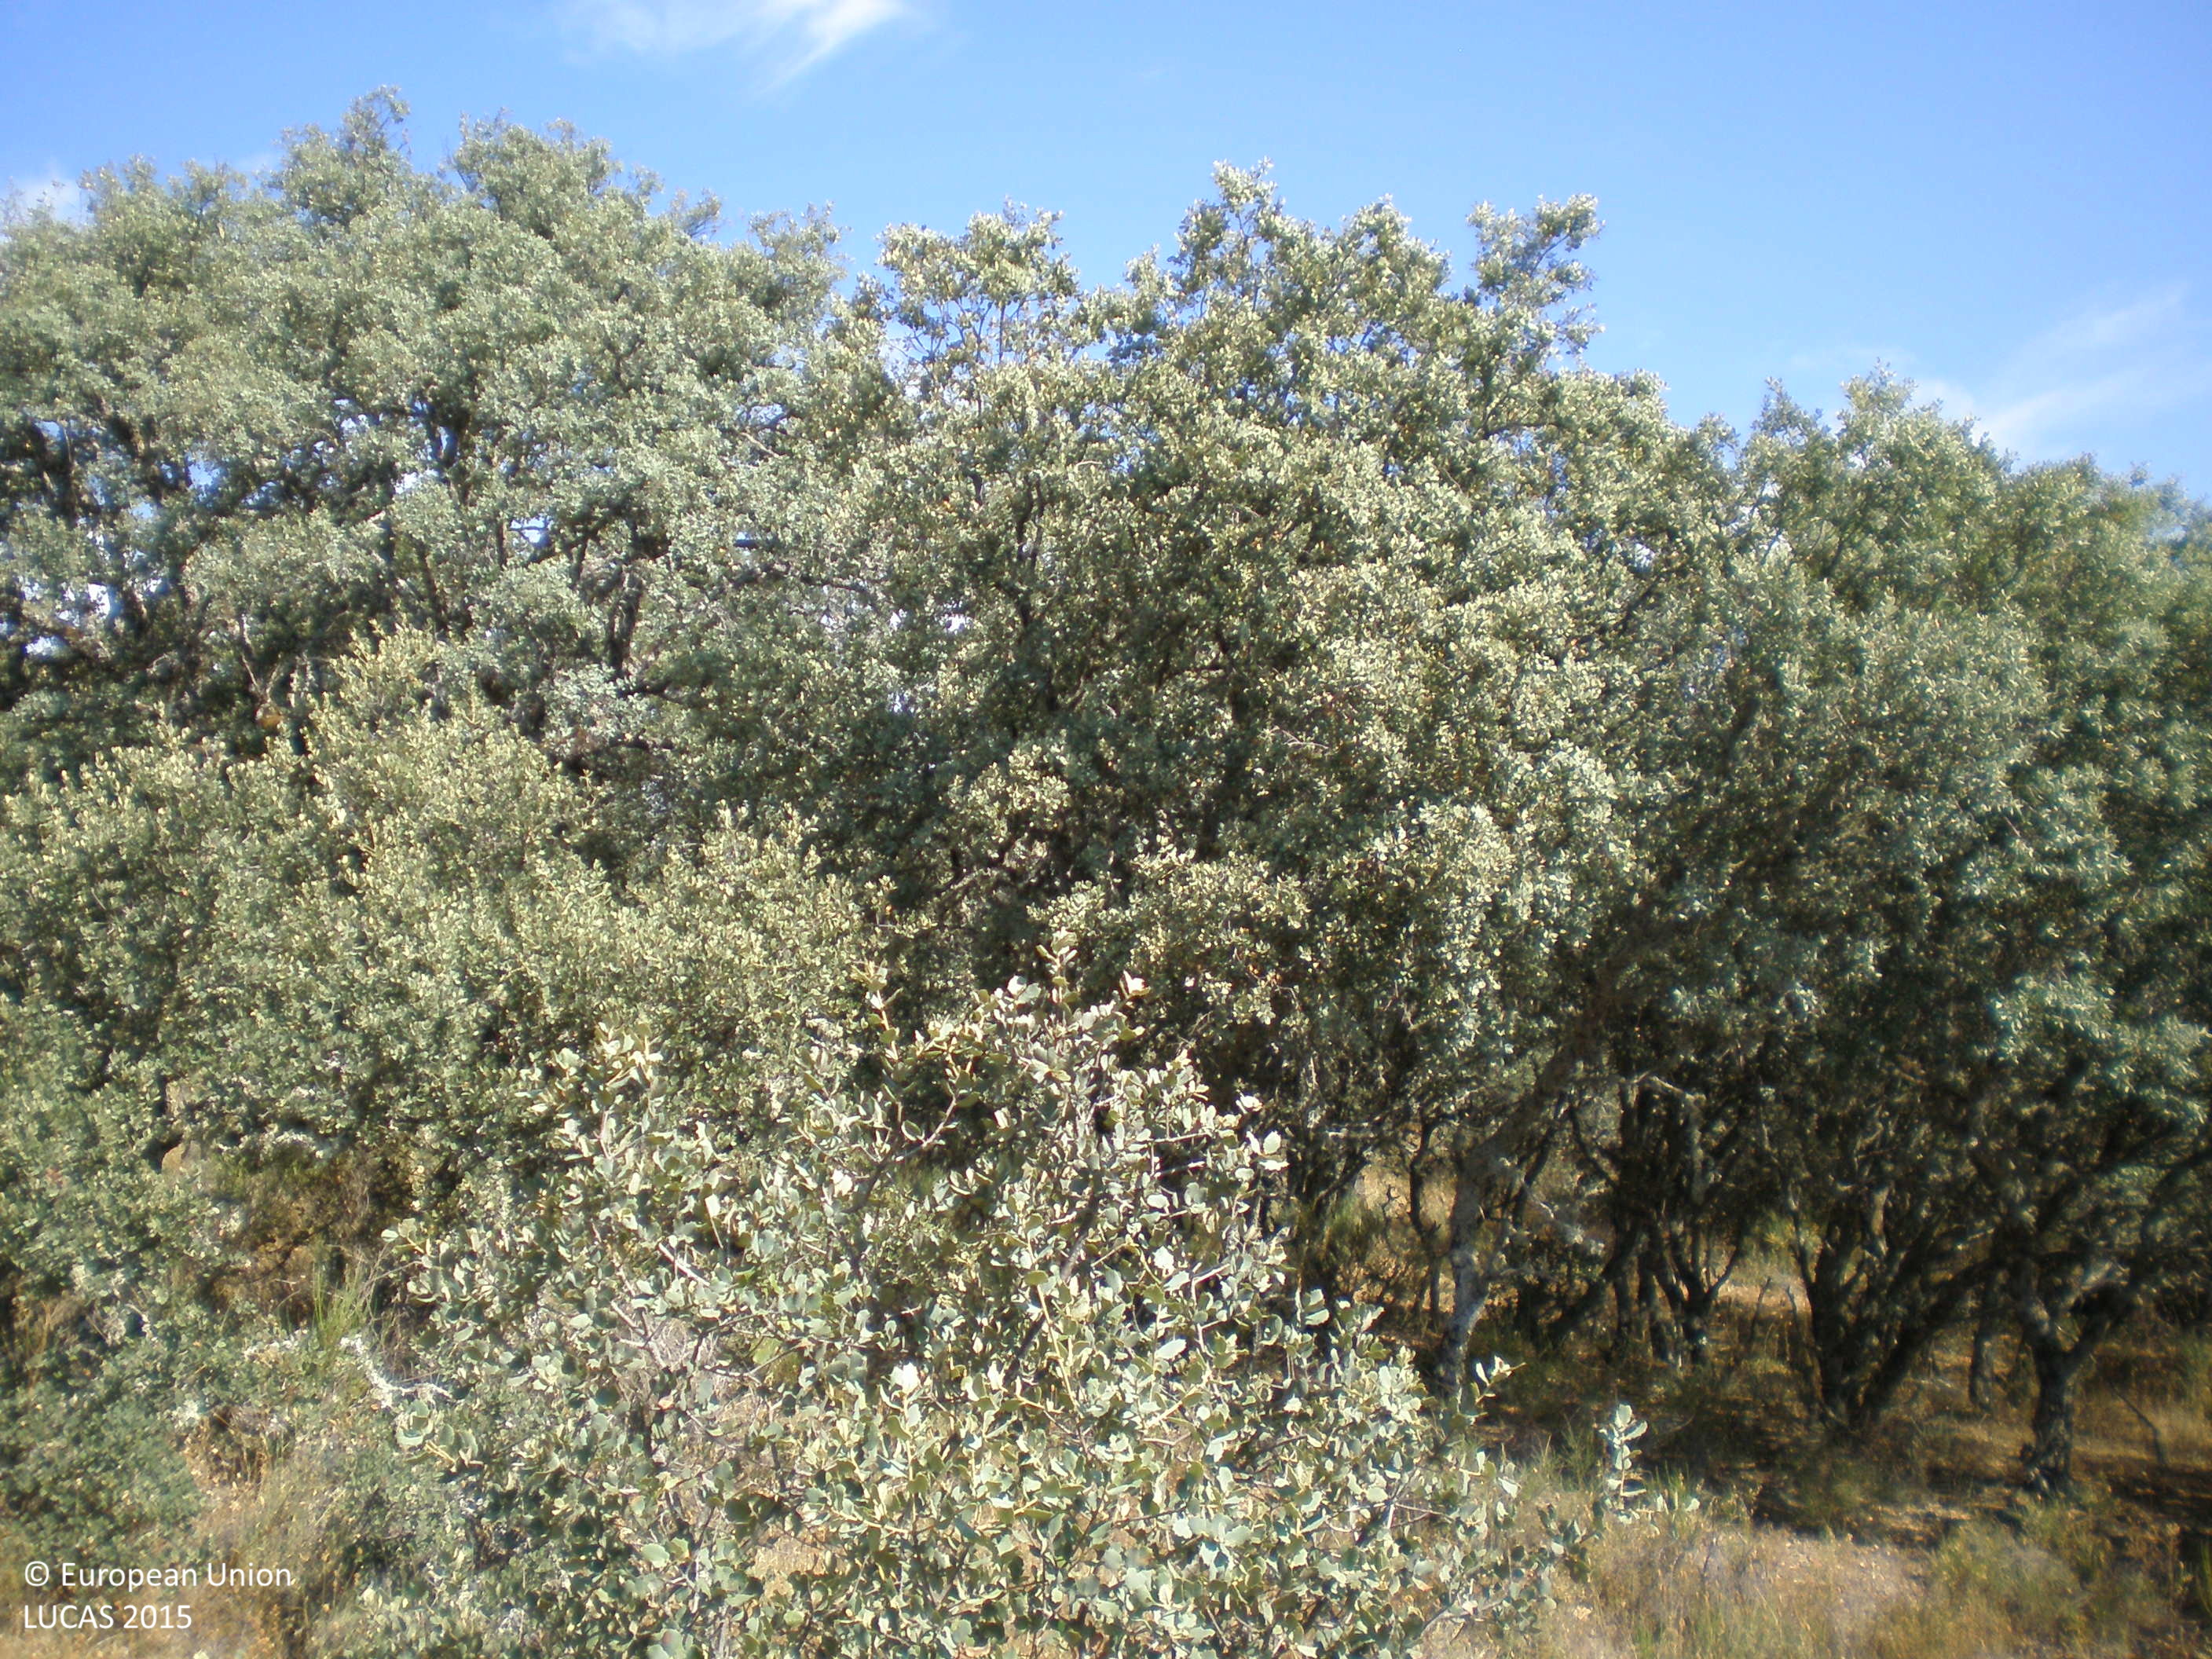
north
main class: Woodland
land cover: Broadleaved woodland
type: broadleaved evergreen forest
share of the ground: 50 - 75 %
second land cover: Grassland without tree/shrub cover
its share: 25 - 50 %
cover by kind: broadleaved forest trees 55 %, herbaceous plants 45 %
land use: Forestry
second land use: Agriculture (excluding fallow land and kitchen gardens)
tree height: > 5 m
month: July
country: ES
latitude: 40.4685
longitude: -5.7942
